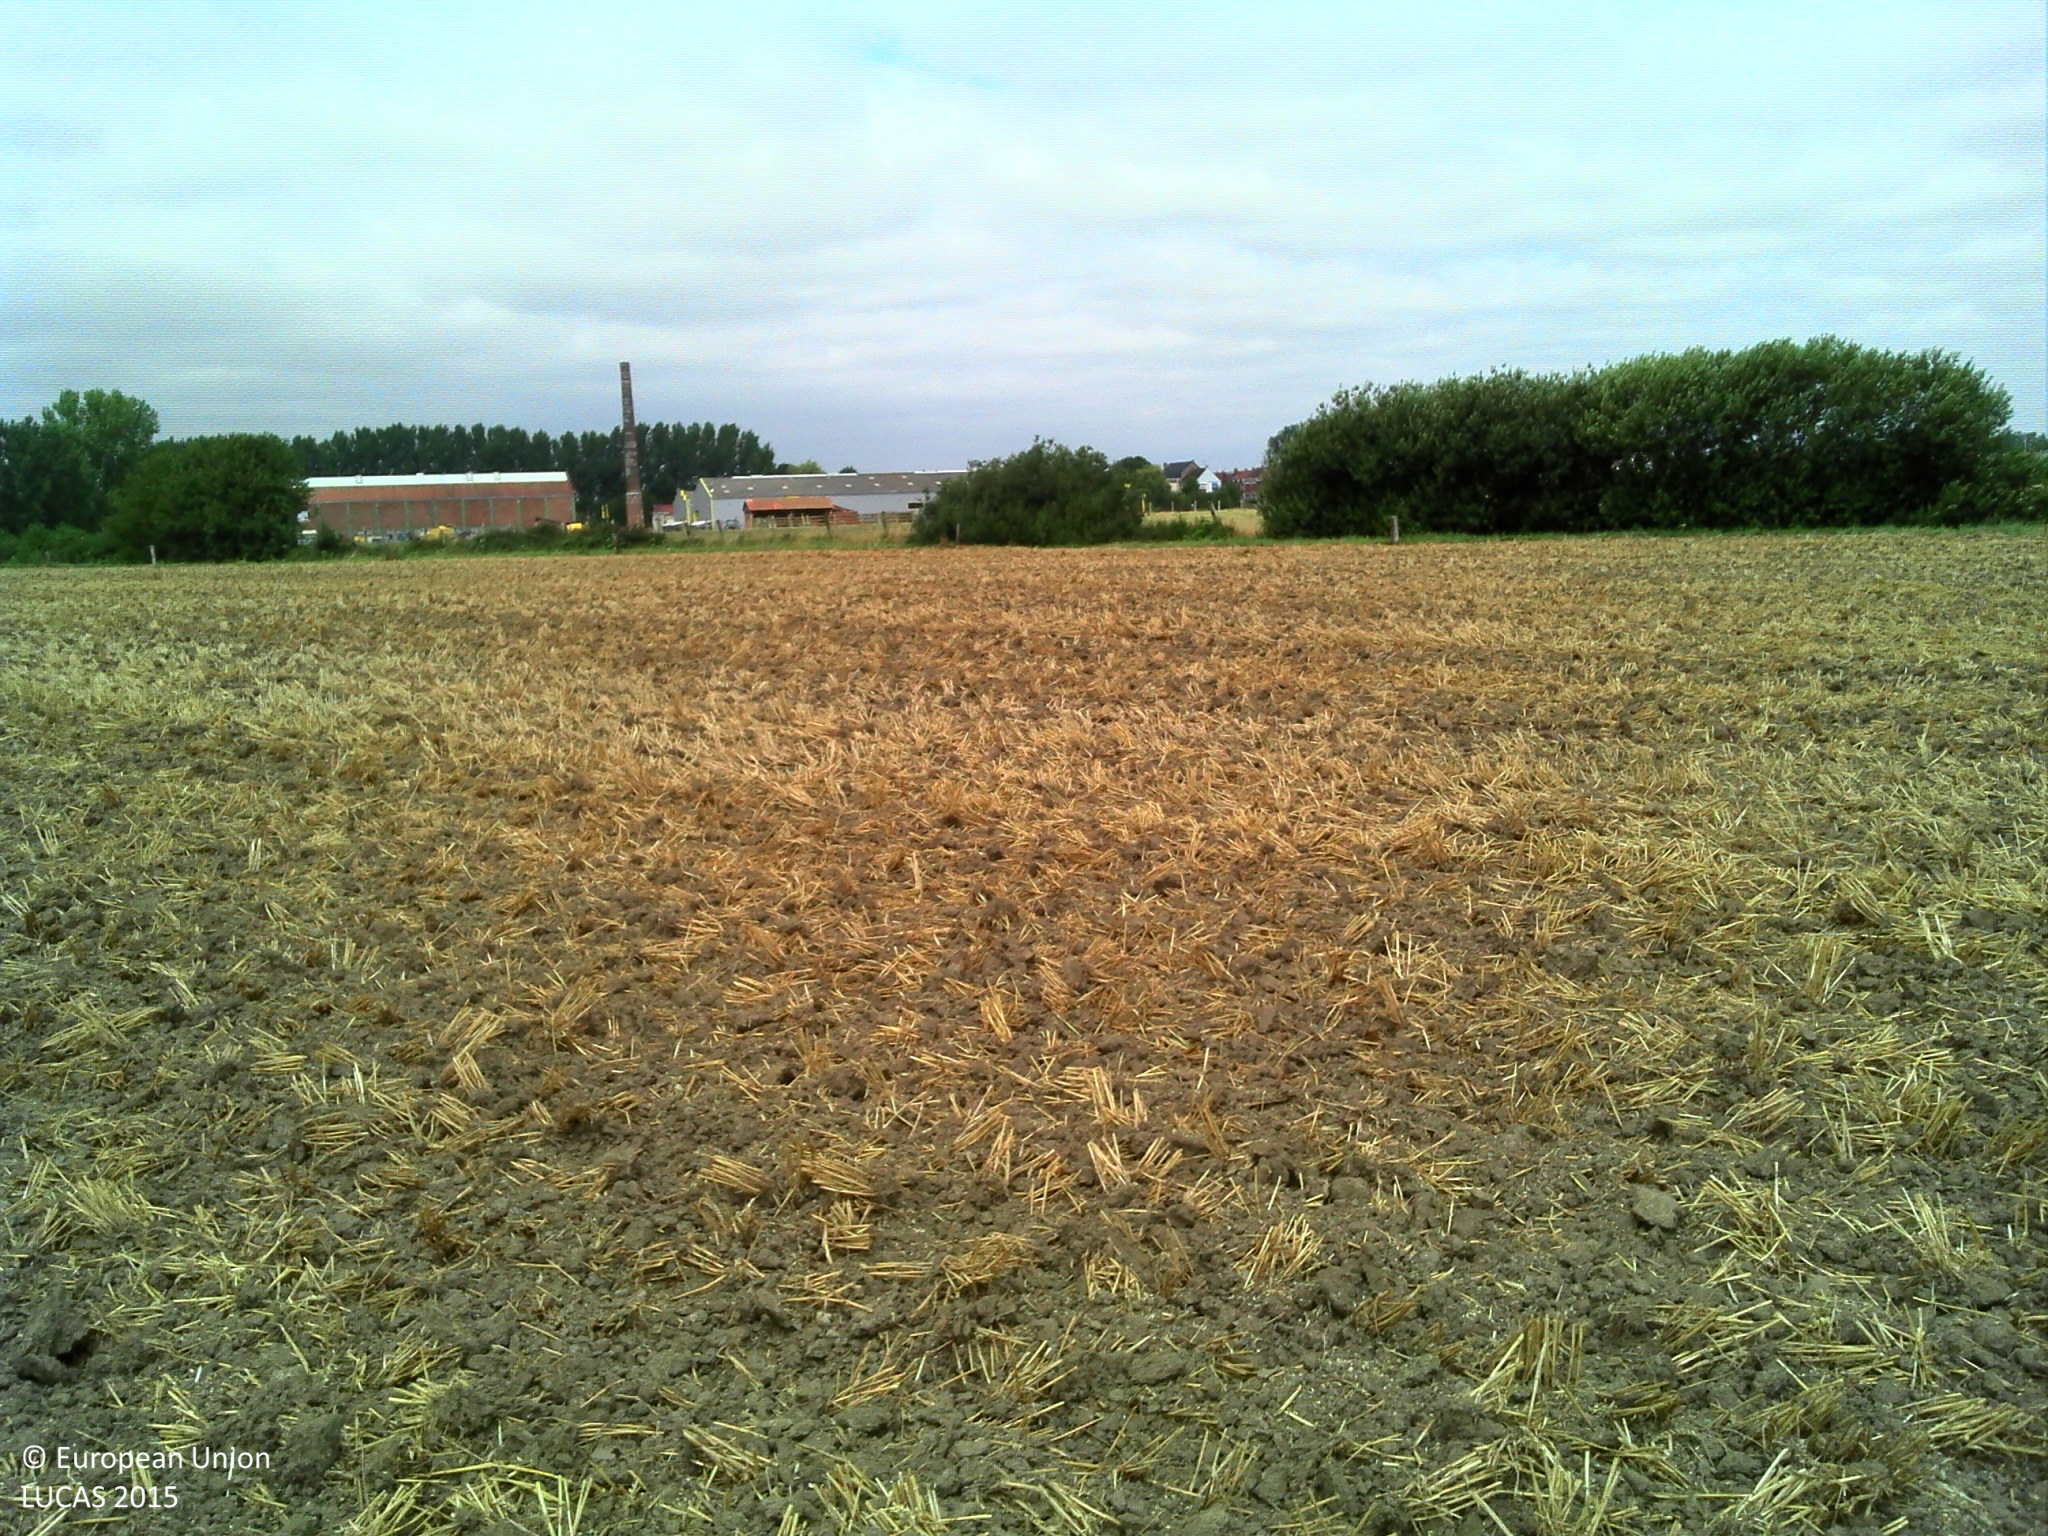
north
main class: Cropland
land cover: Common wheat
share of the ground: < 10 %
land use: Agriculture (excluding fallow land and kitchen gardens)
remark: Harvested field
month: August
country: FR
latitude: 50.6384
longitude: 2.7349
